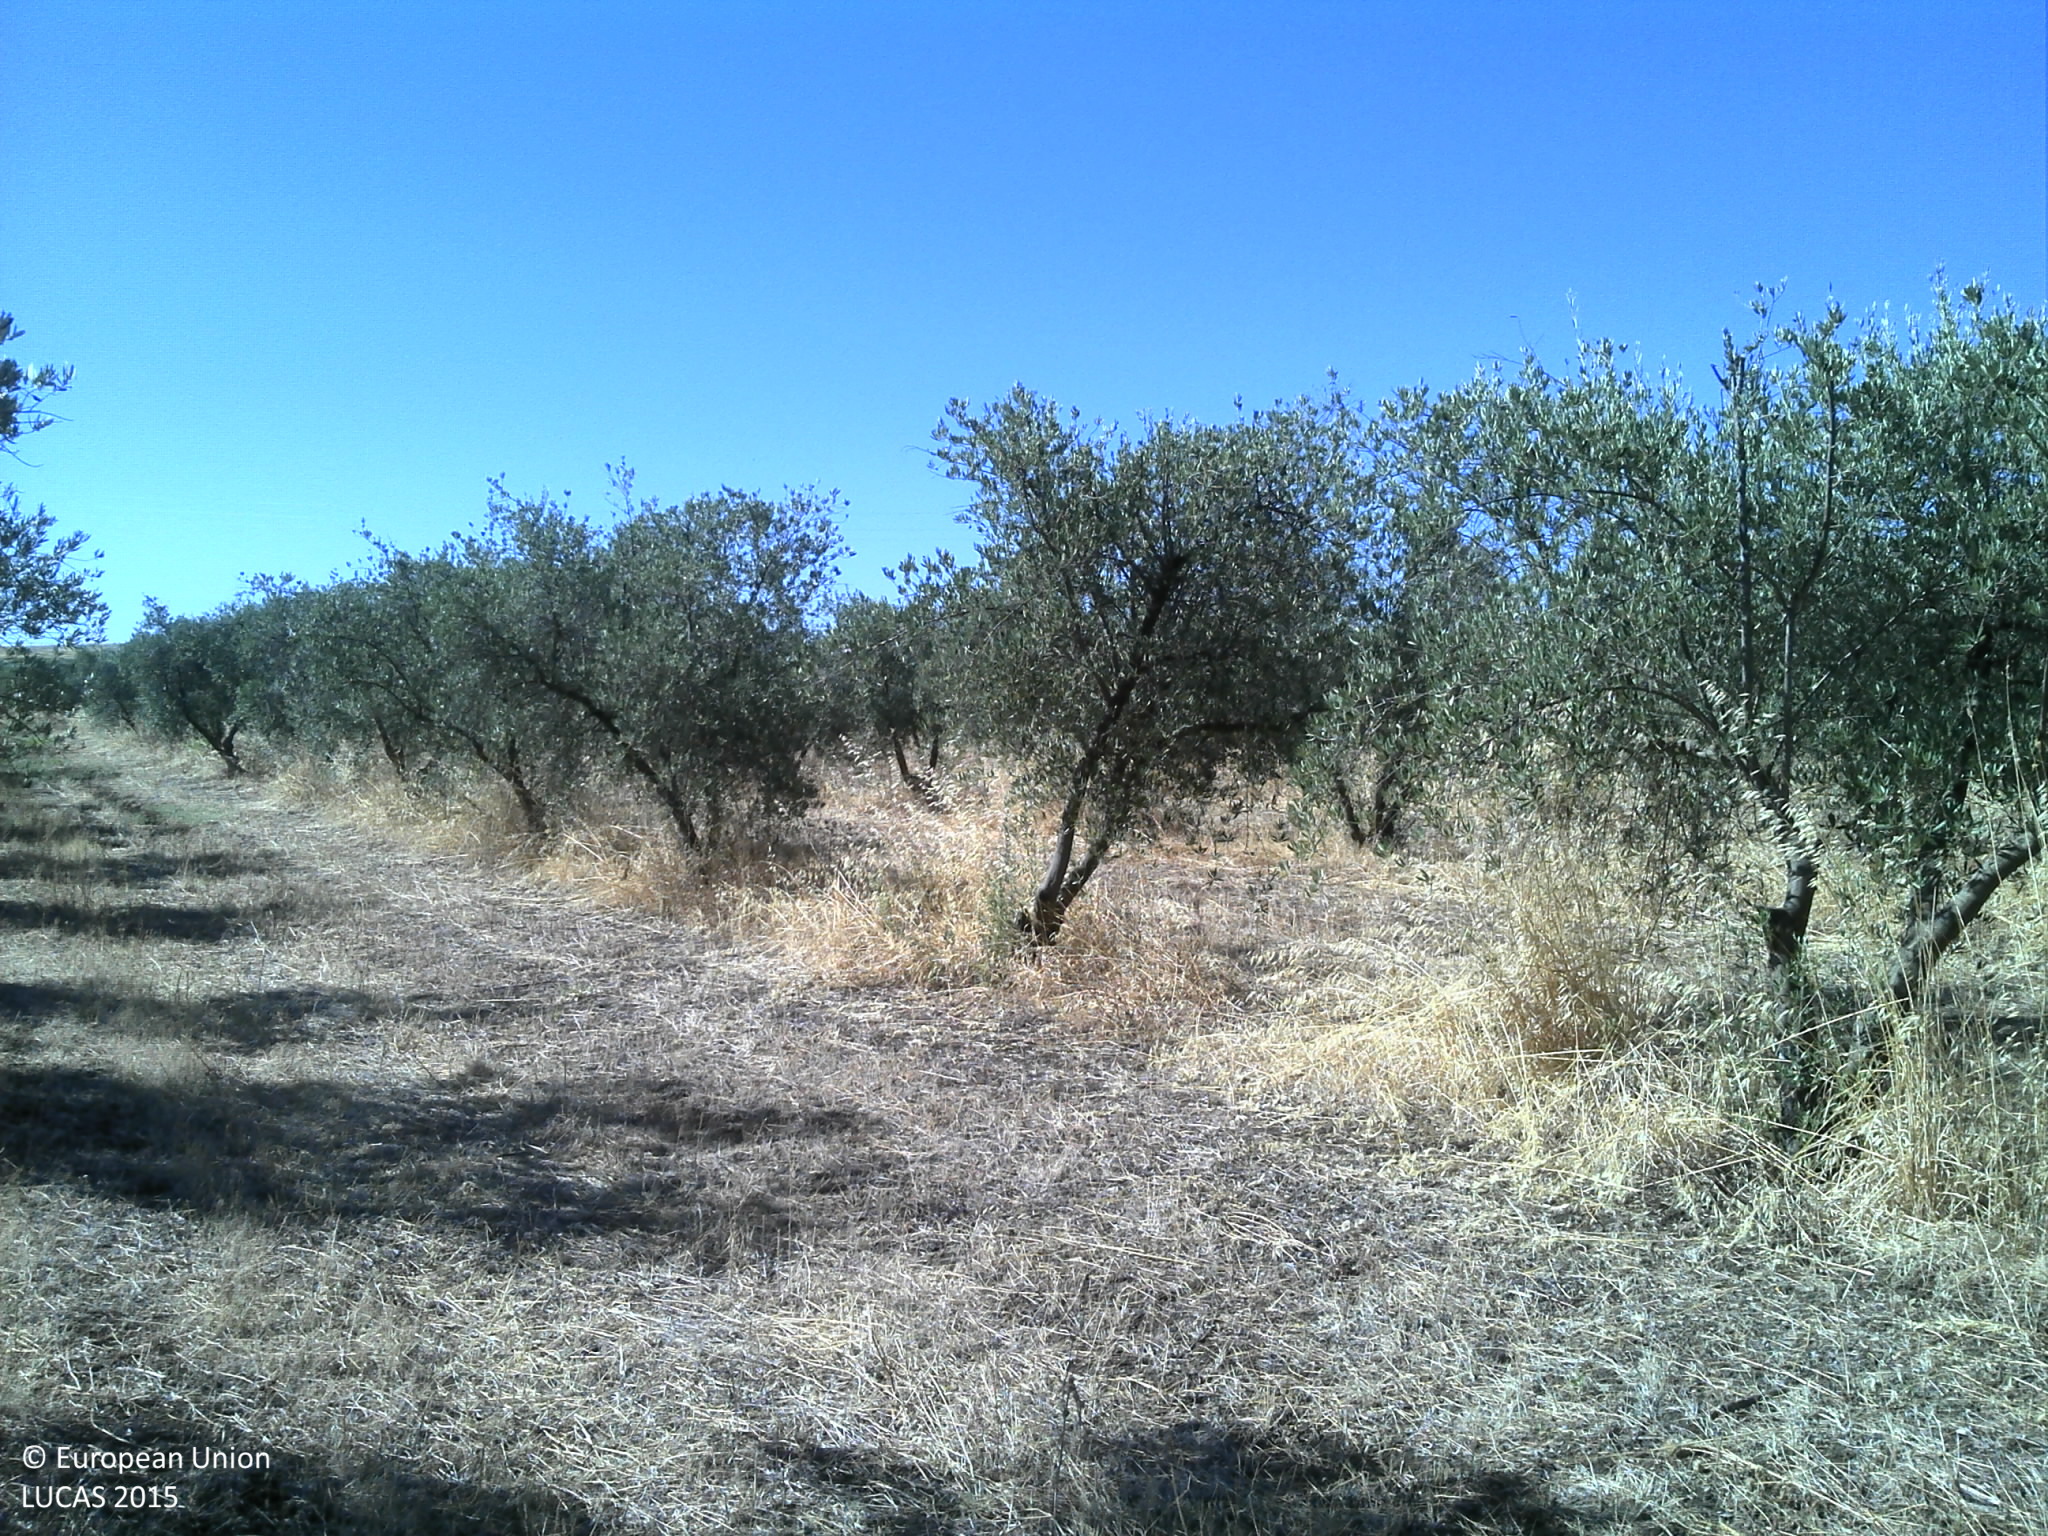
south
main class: Cropland
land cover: Olive groves
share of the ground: 50 - 75 %
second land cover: Grassland without tree/shrub cover
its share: 10 - 25 %
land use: Agriculture (excluding fallow land and kitchen gardens)
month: July
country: PT
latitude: 39.0318
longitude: -7.0912
